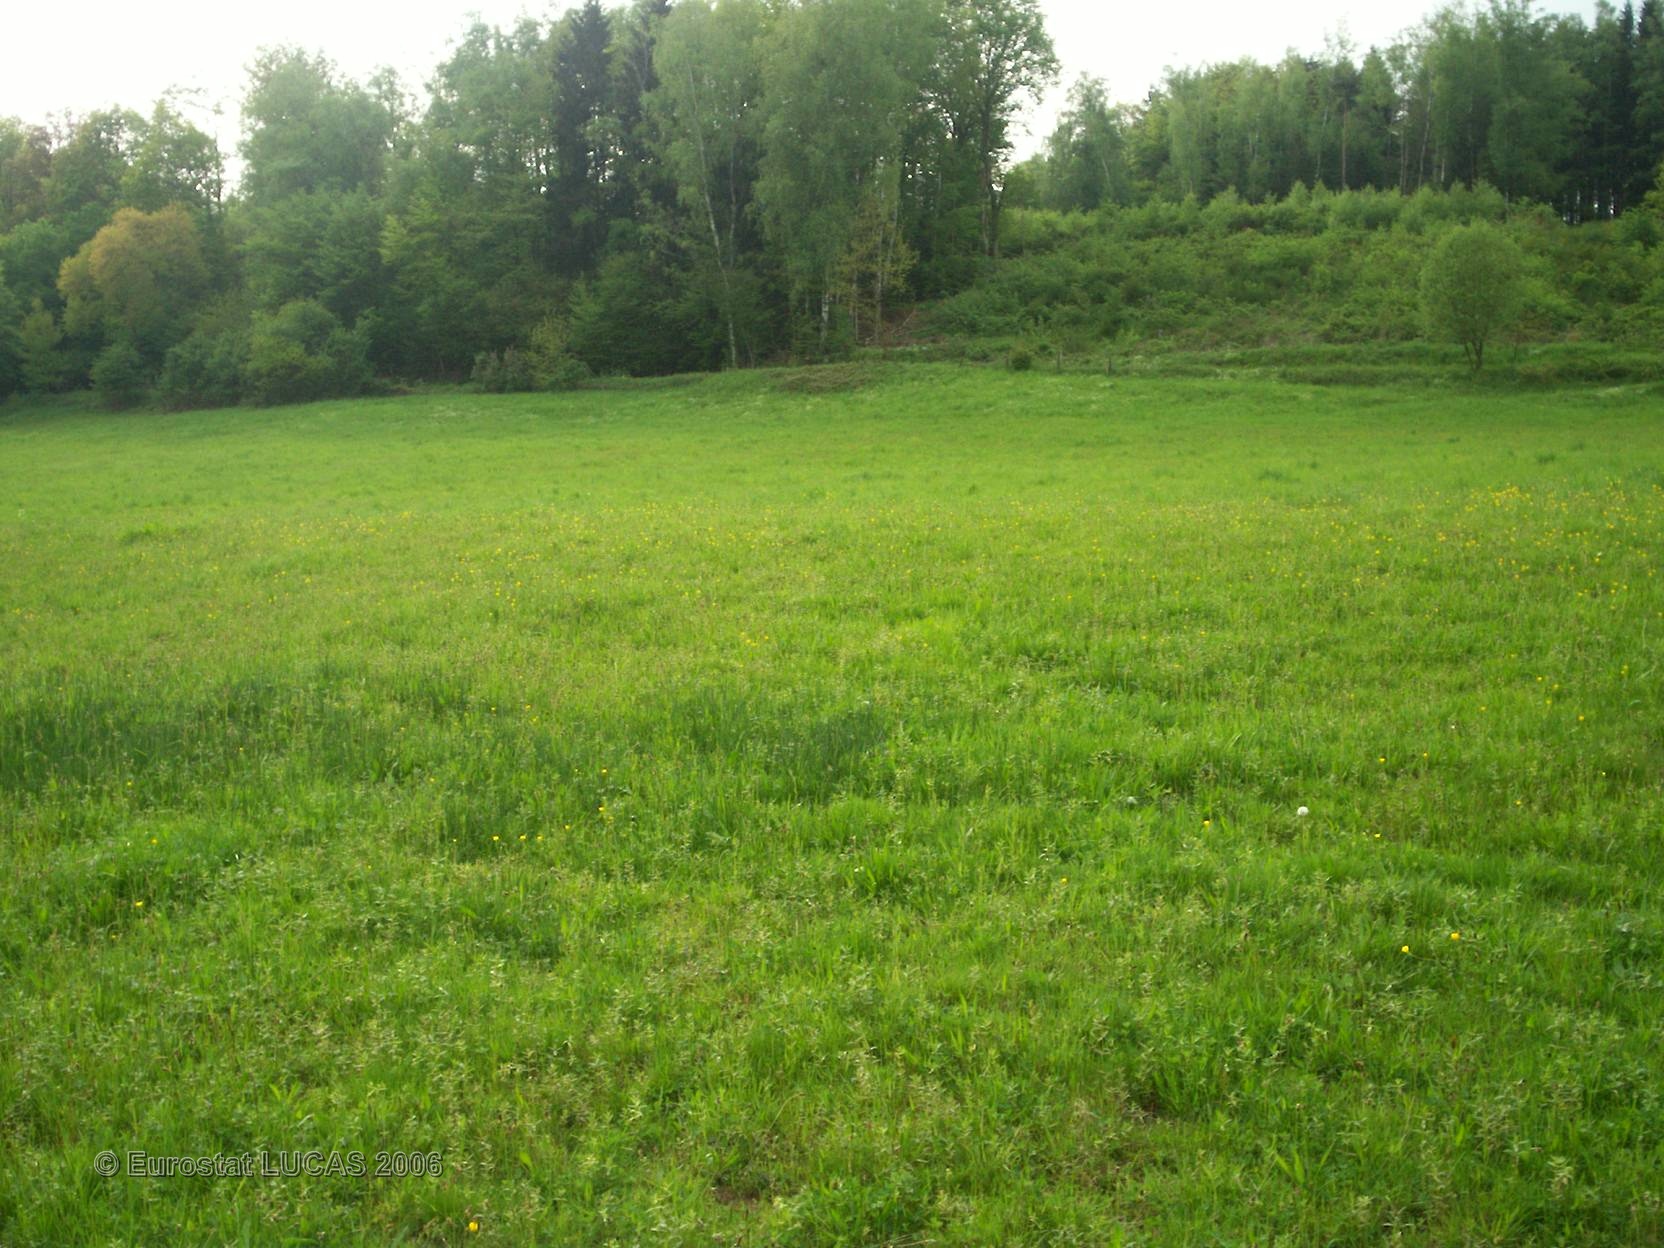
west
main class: Grassland
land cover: Grassland without tree/shrub cover
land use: Agriculture (excluding fallow land and kitchen gardens)
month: May
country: FR
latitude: 48.5970
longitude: 7.0040
